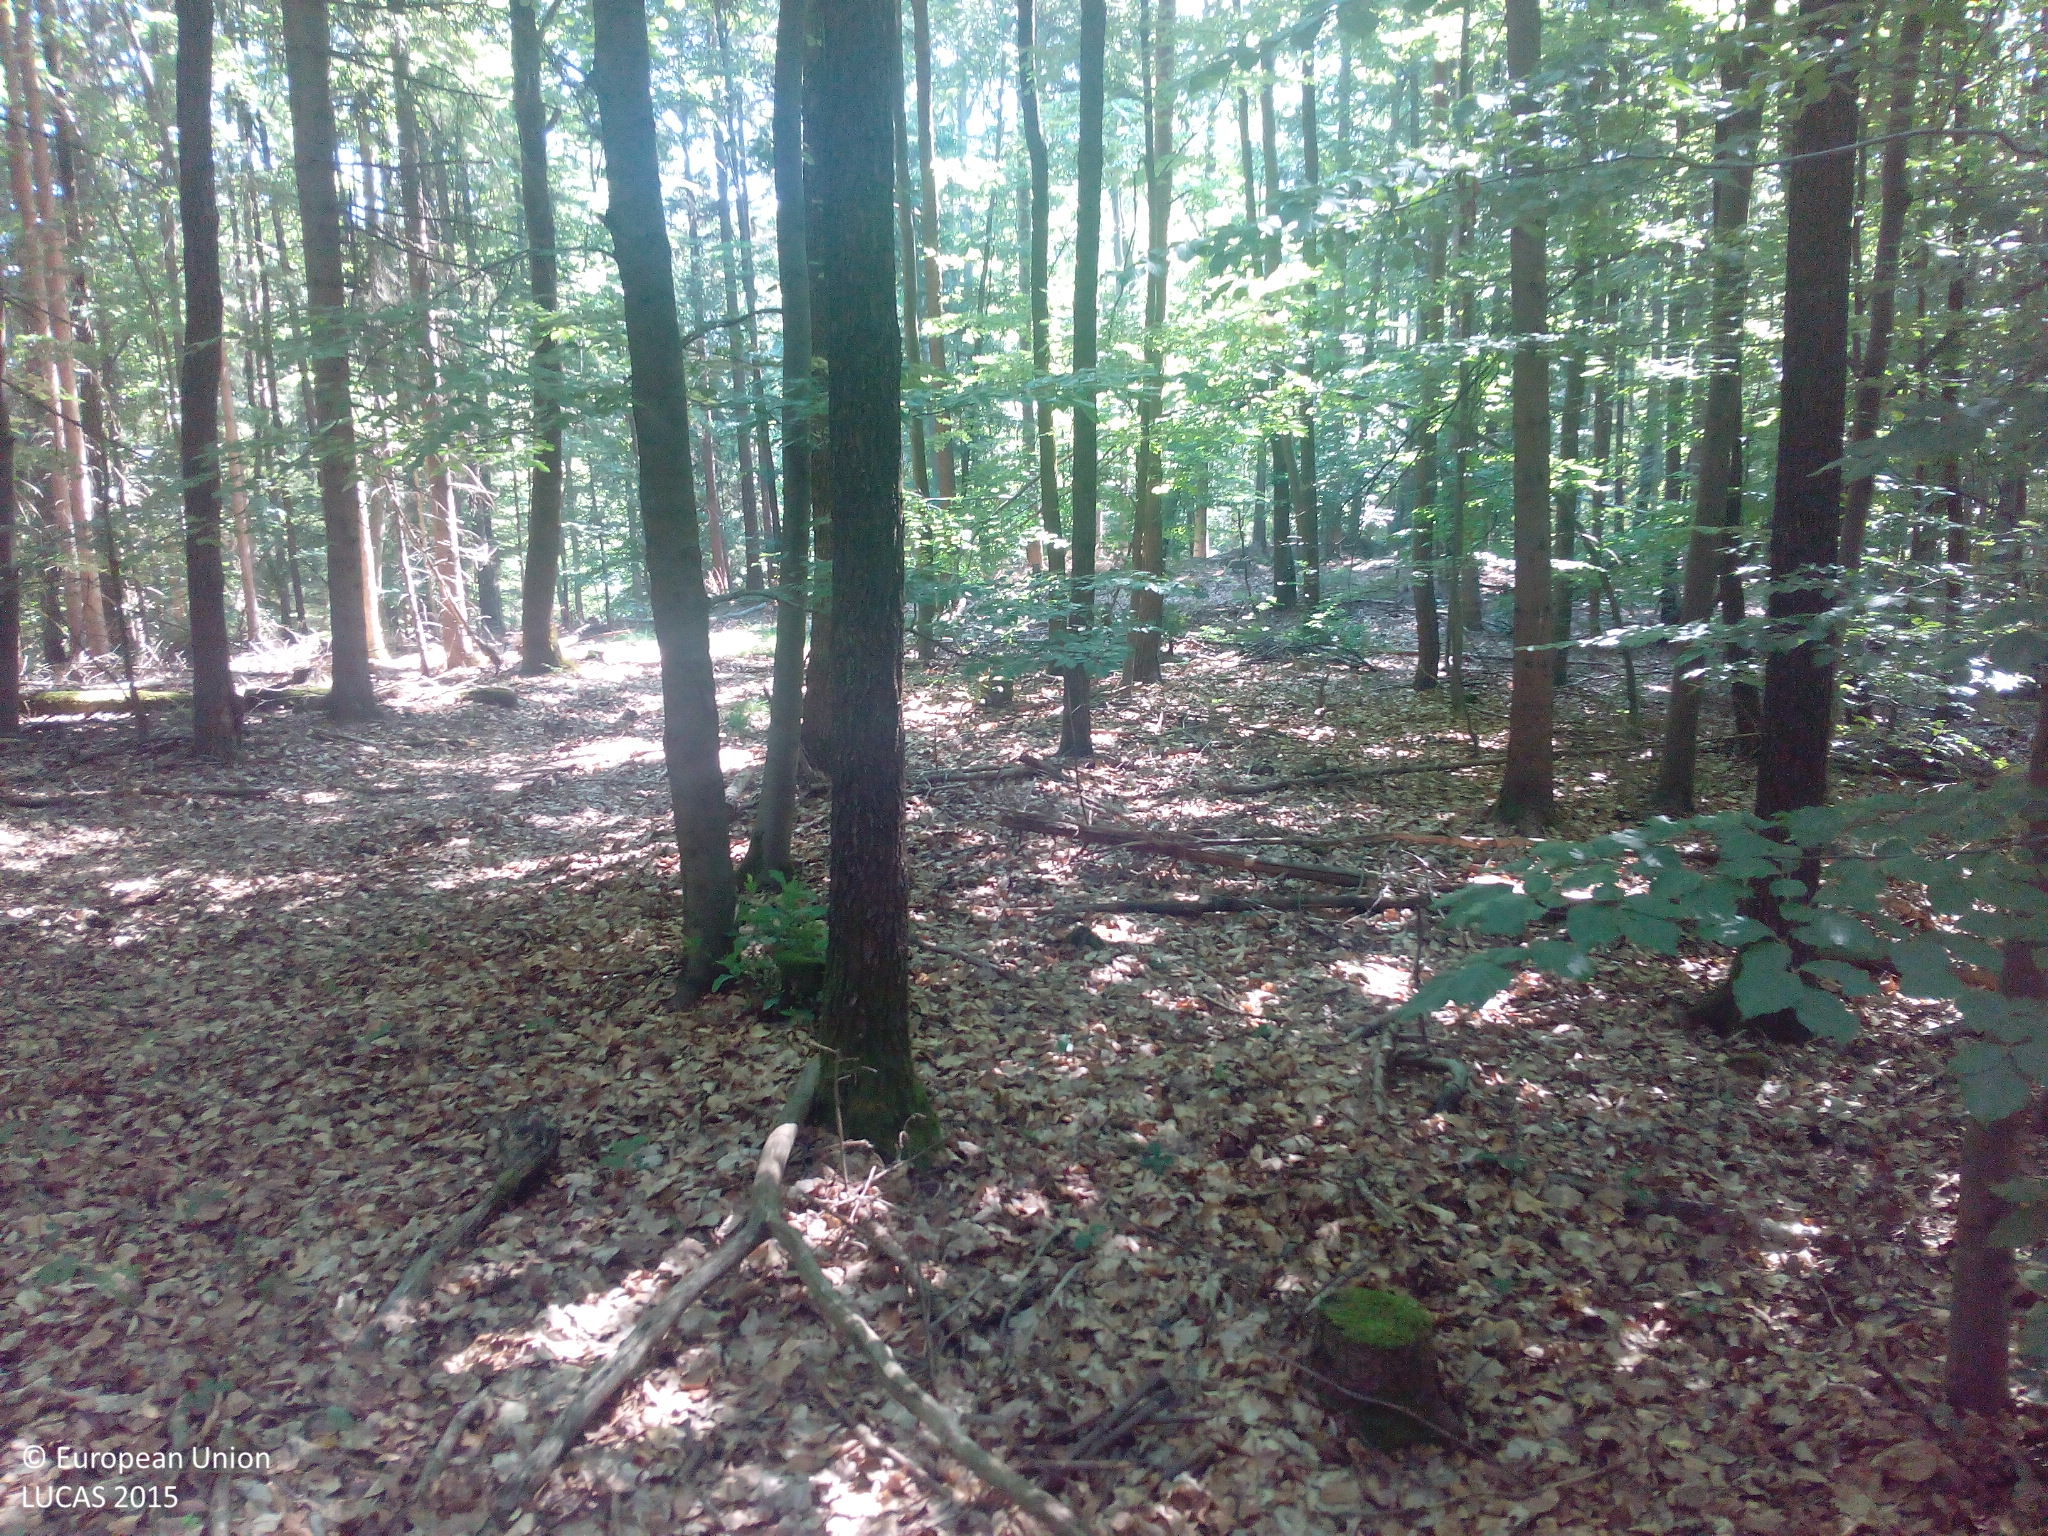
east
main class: Woodland
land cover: Spruce dominated mixed woodland
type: hemiboreal forest and nemoral coniferous forest and mixed broadleaved-coniferous forest
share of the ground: > 75 %
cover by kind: coniferous forest trees 70 %, broadleaved forest trees 25 %, unconsolidated bare surface 5 %
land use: Forestry
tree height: > 5 m
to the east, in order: Spruce dominated mixed woodland; Tracks; Other mixed woodland; Spruce dominated mixed woodland; Pine dominated mixed woodland; Spruce dominated mixed woodland; Tracks; Spruce dominated mixed woodland
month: July
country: DE
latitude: 50.2529
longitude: 10.8553
